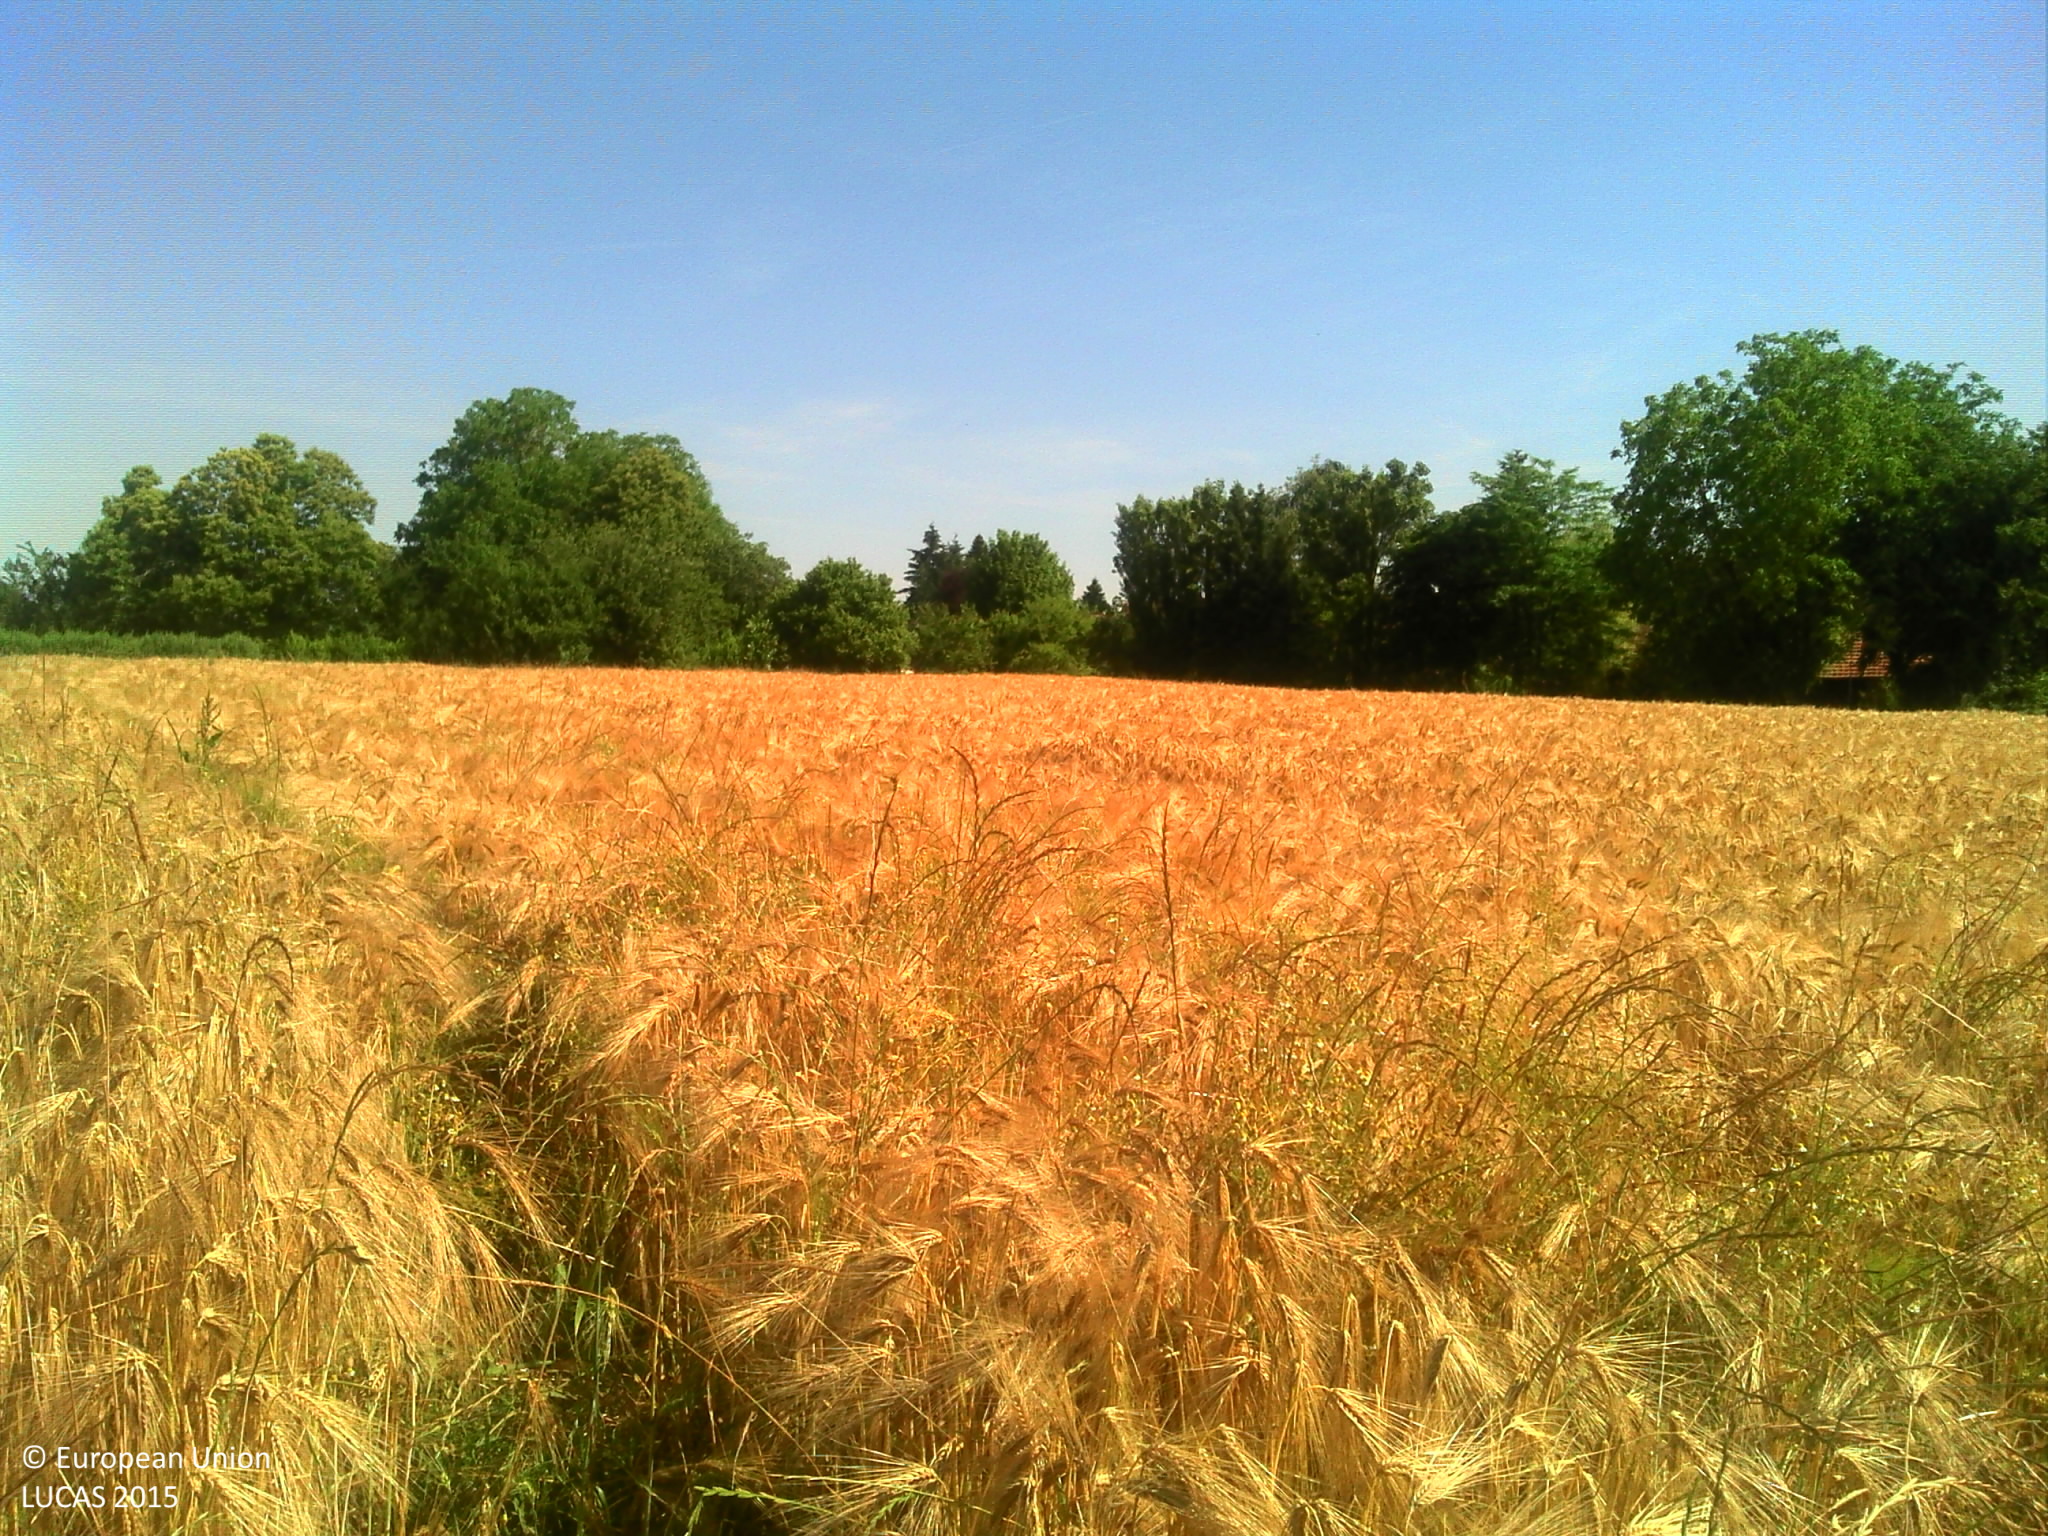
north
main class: Cropland
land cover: Barley
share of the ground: > 75 %
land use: Agriculture (excluding fallow land and kitchen gardens)
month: June
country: FR
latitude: 47.0921
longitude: 5.2191
